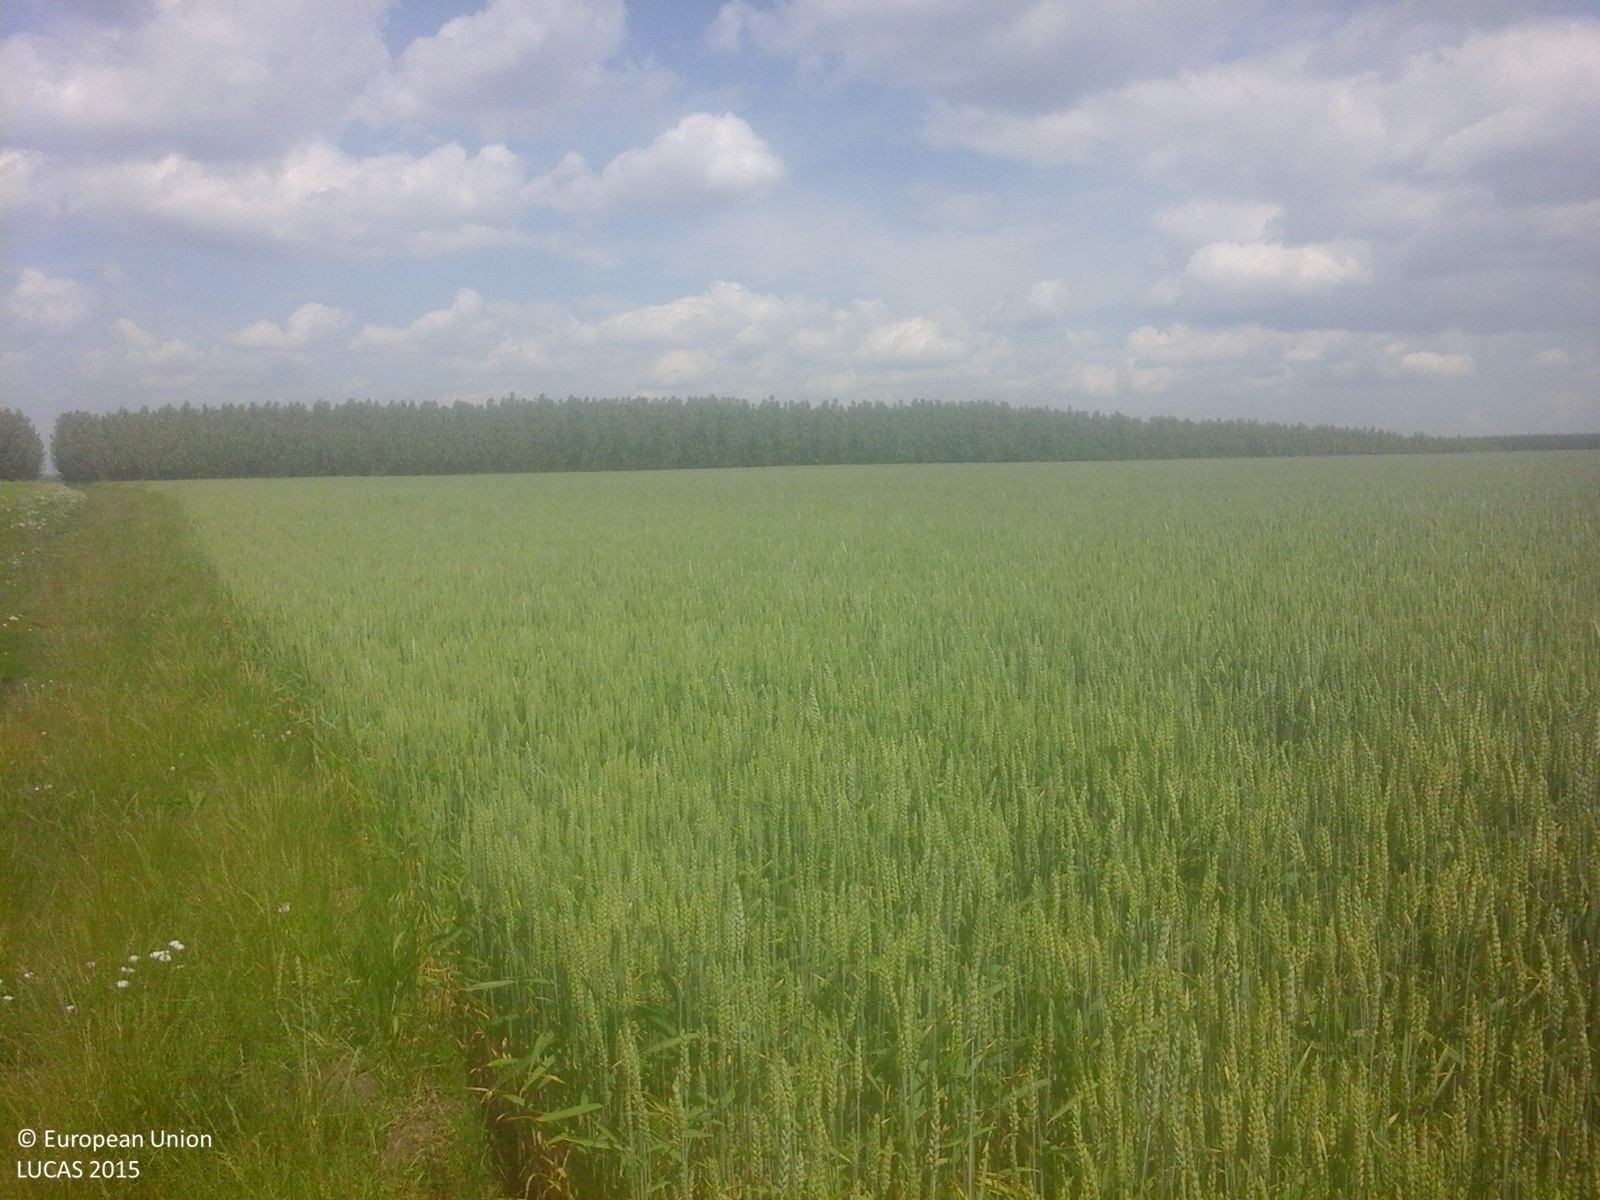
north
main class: Cropland
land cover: Common wheat
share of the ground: > 75 %
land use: Agriculture (excluding fallow land and kitchen gardens)
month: June
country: RO
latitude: 47.9052
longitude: 26.0117
